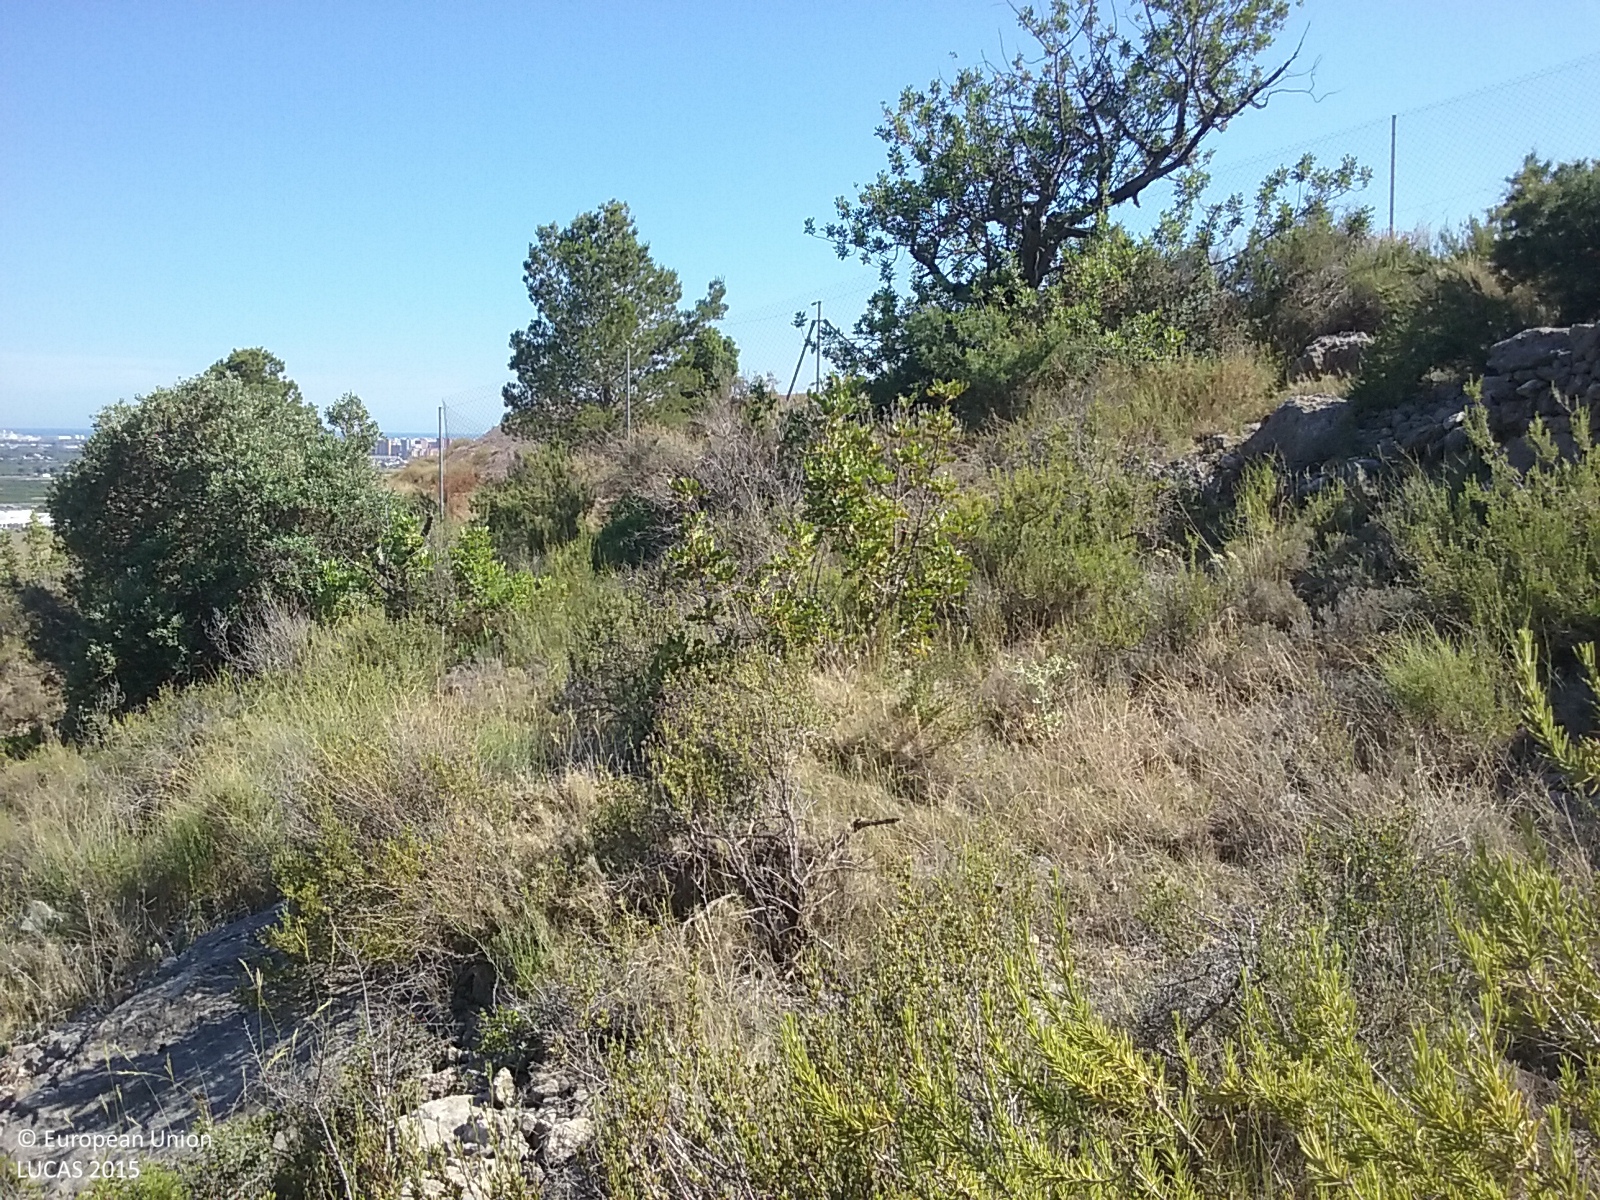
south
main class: Cropland
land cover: Permanent industrial crops
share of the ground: < 10 %
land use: Abandoned areas
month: June
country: ES
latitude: 40.0240
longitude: -0.0432
